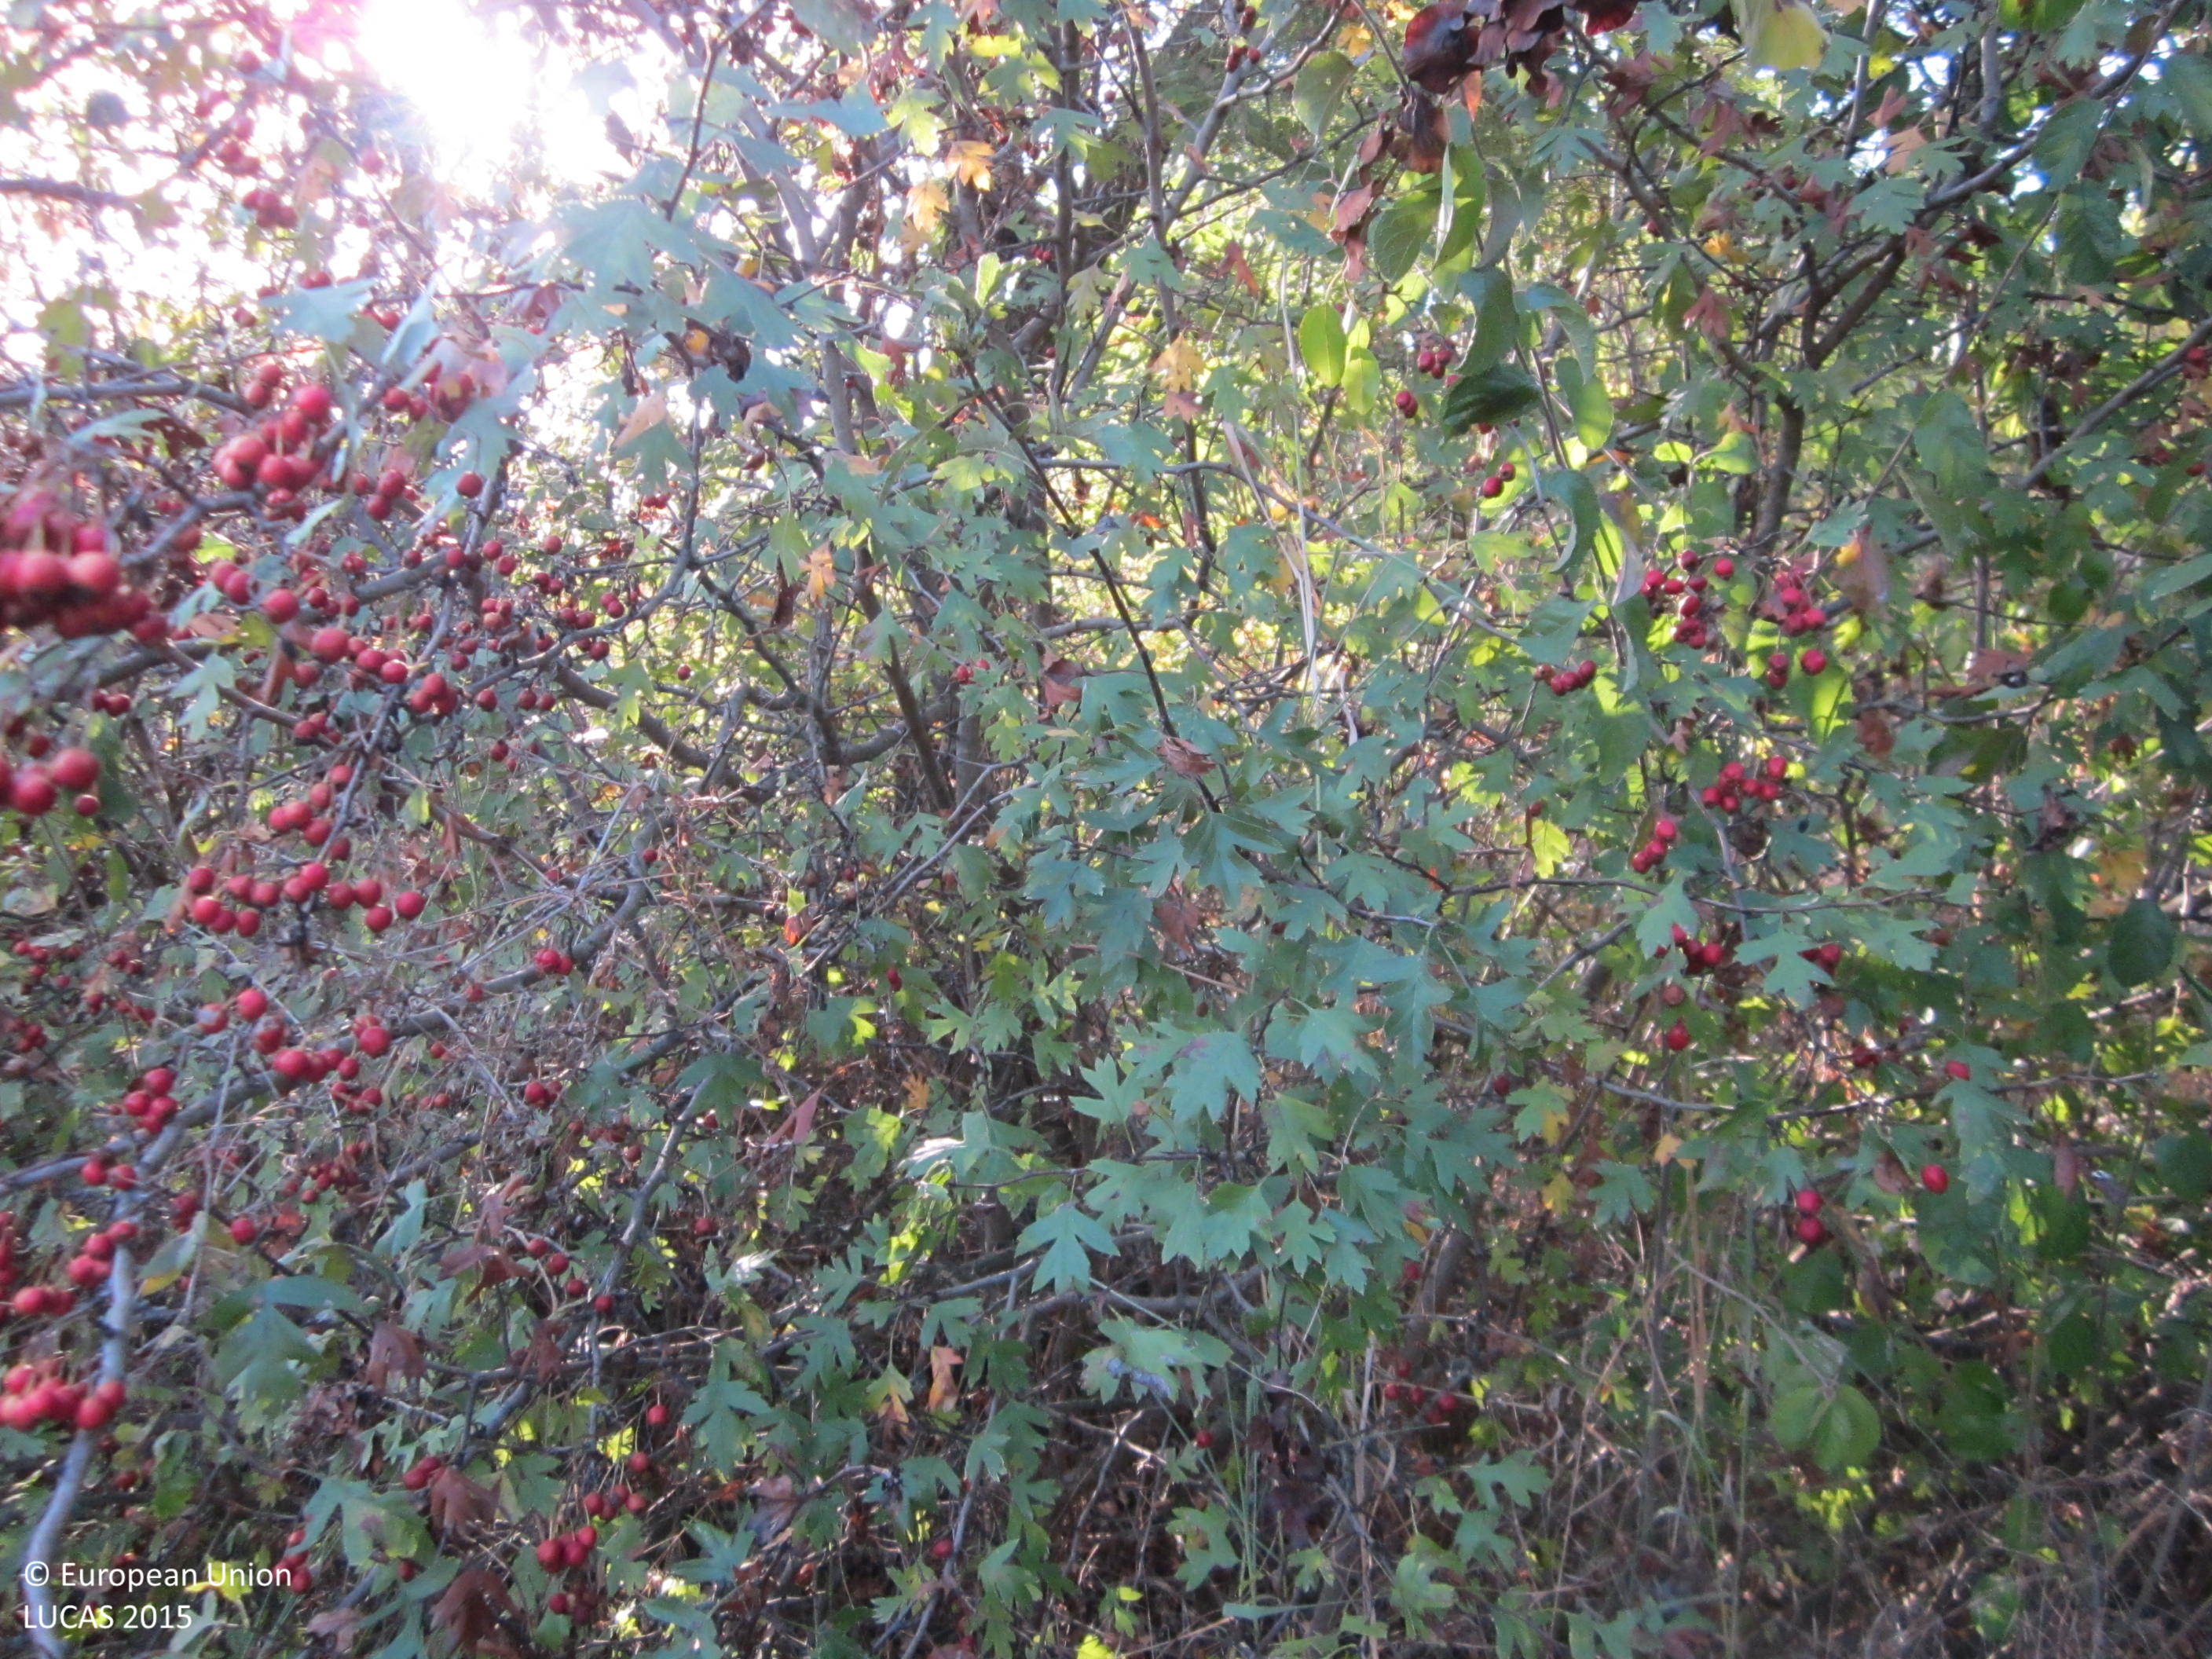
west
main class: Shrubland
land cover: Shrubland with sparse tree cover
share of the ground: > 75 %
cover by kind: shrubs 80 %, herbaceous plants 15 %, broadleaved forest trees 5 %
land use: Semi-natural and natural areas not in use
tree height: < 5 m
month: September
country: BG
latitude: 42.6630
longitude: 27.4053
